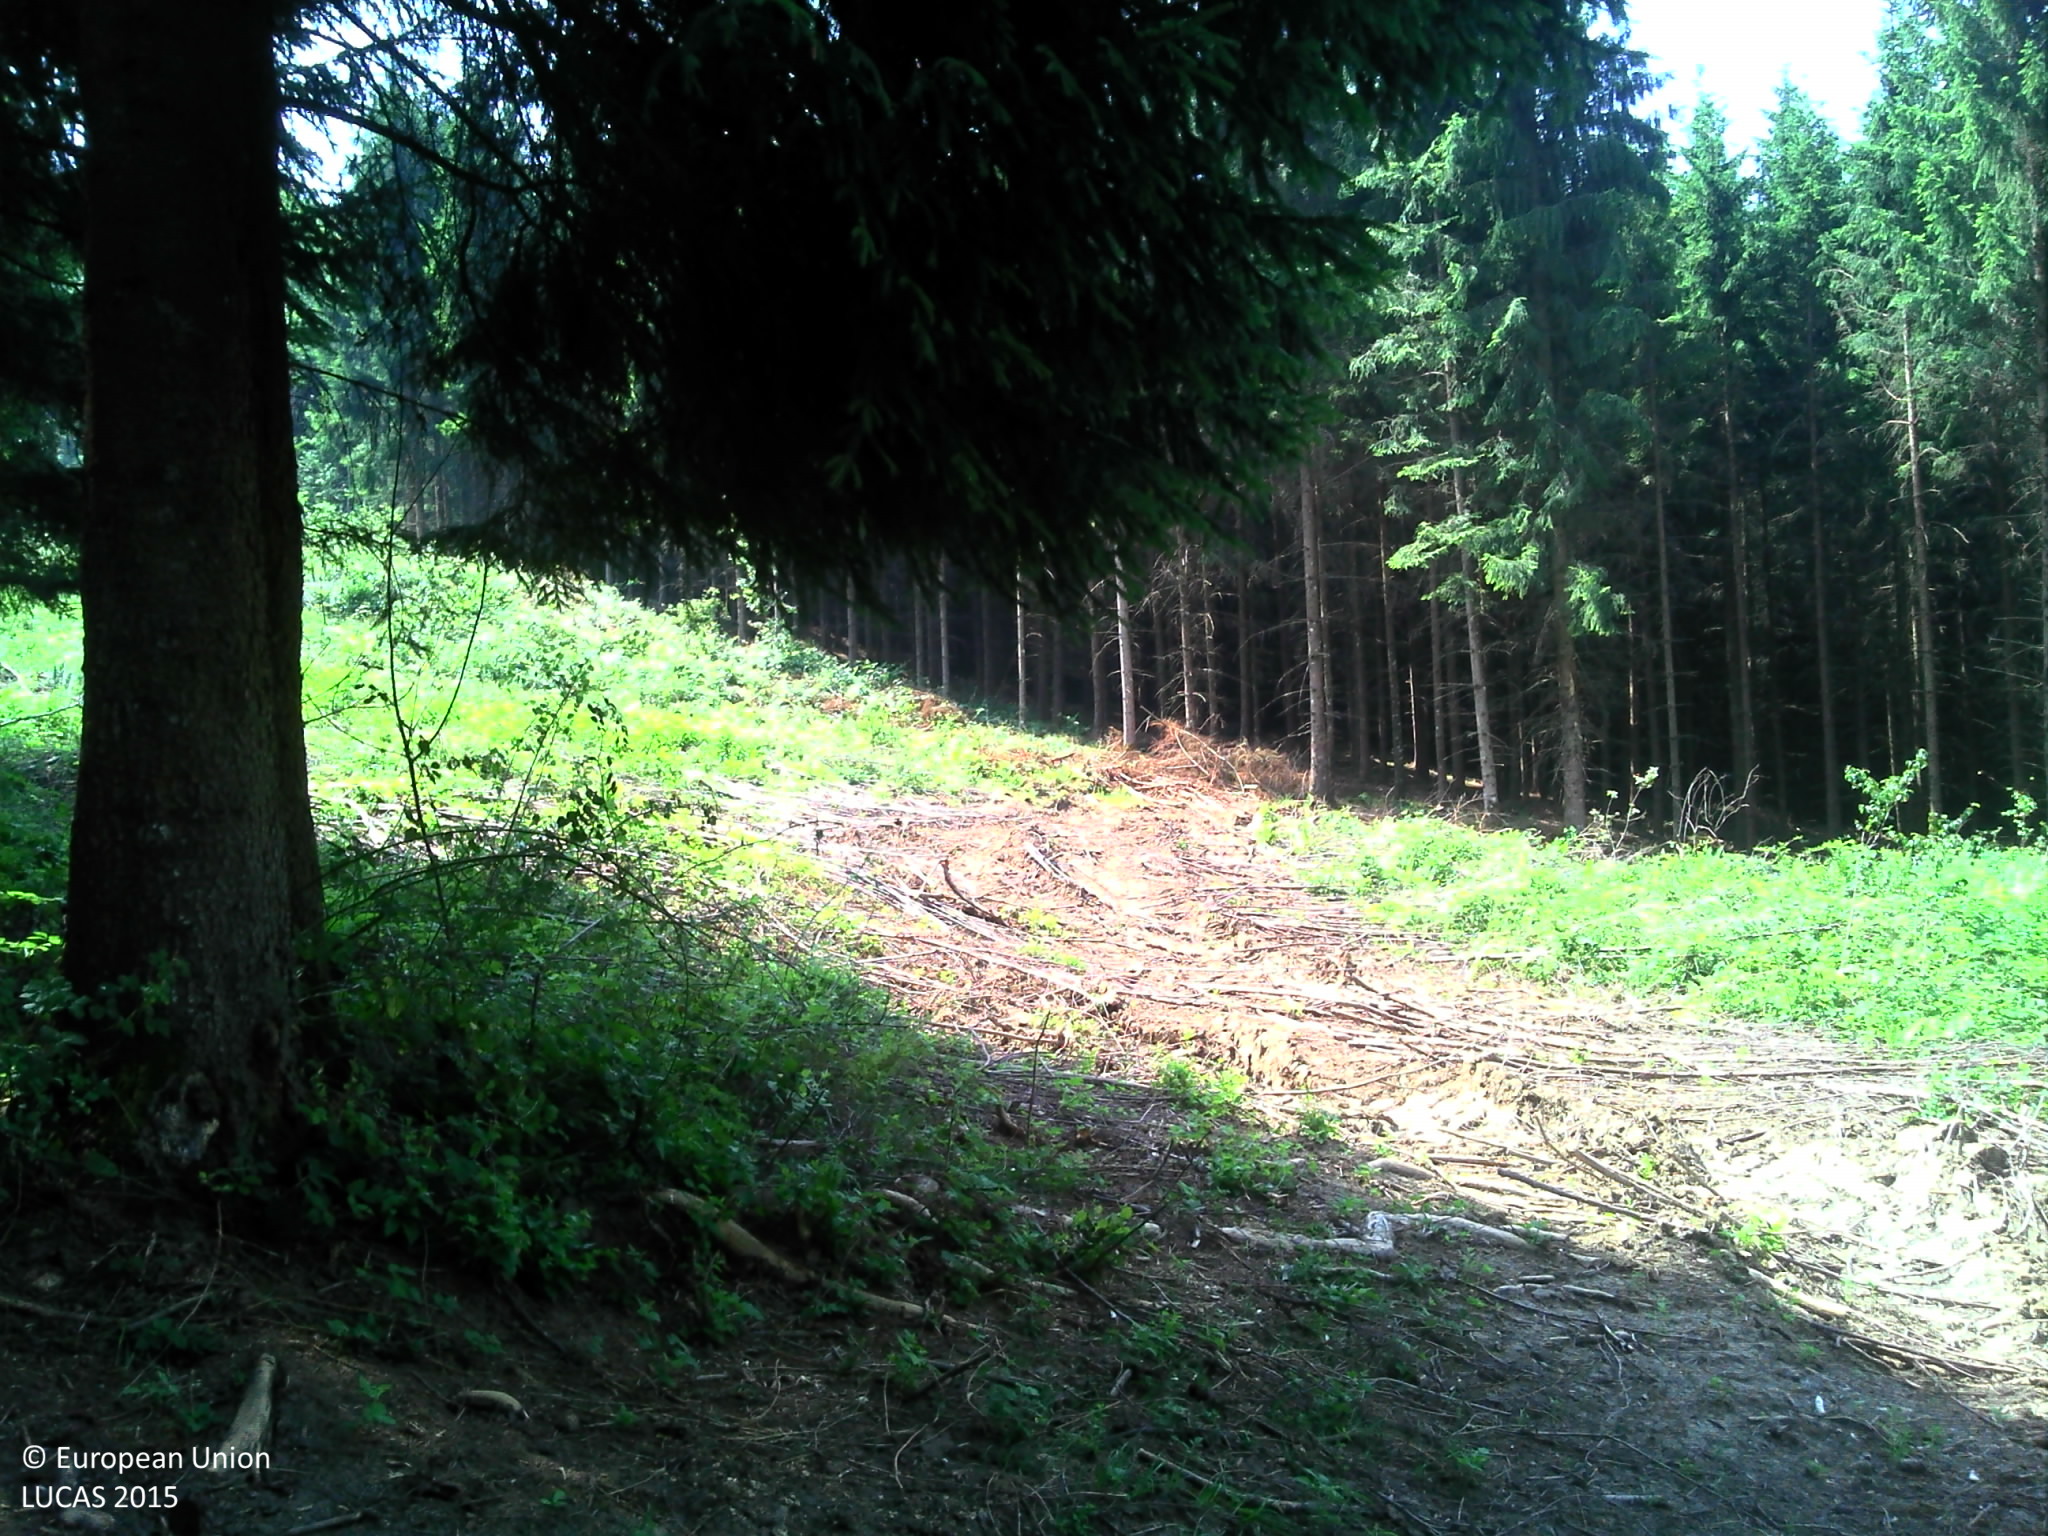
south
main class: Woodland
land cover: Spruce dominated coniferous woodland
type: alpine coniferous forest
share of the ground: > 75 %
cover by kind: coniferous forest trees 85 %, broadleaved forest trees 5 %, herbaceous plants 5 %, lichens and mosses 5 %
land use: Forestry
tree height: > 5 m
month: July
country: FR
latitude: 45.8133
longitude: 6.1562
